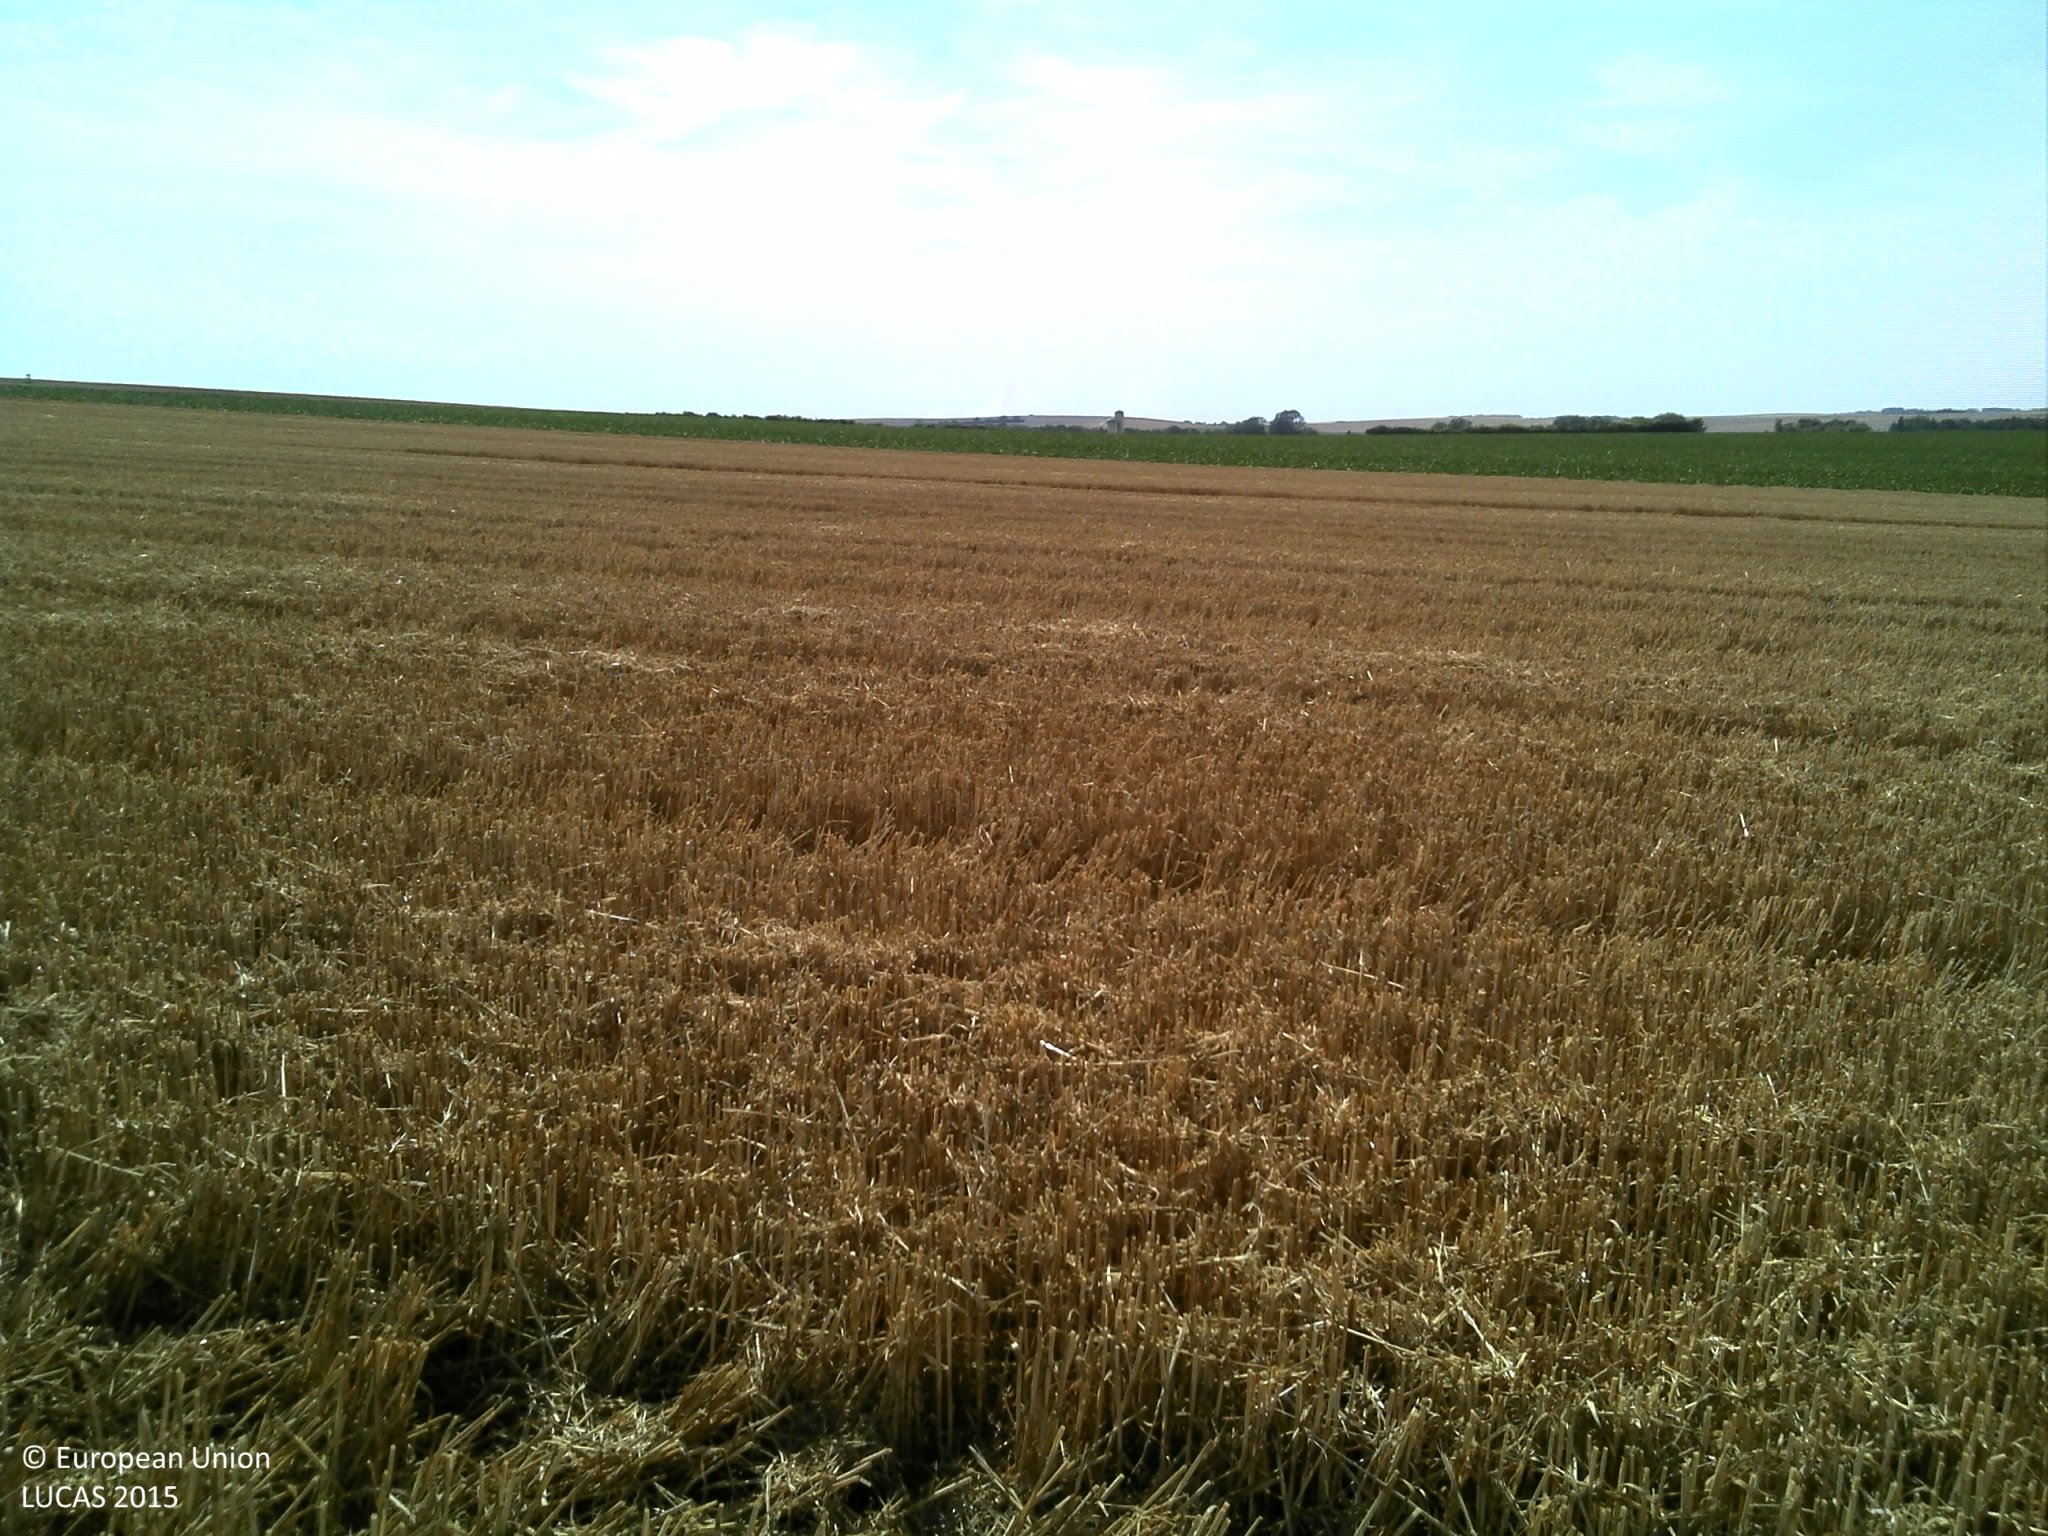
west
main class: Cropland
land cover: Common wheat
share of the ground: > 75 %
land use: Agriculture (excluding fallow land and kitchen gardens)
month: August
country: FR
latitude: 49.1235
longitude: 4.6941
